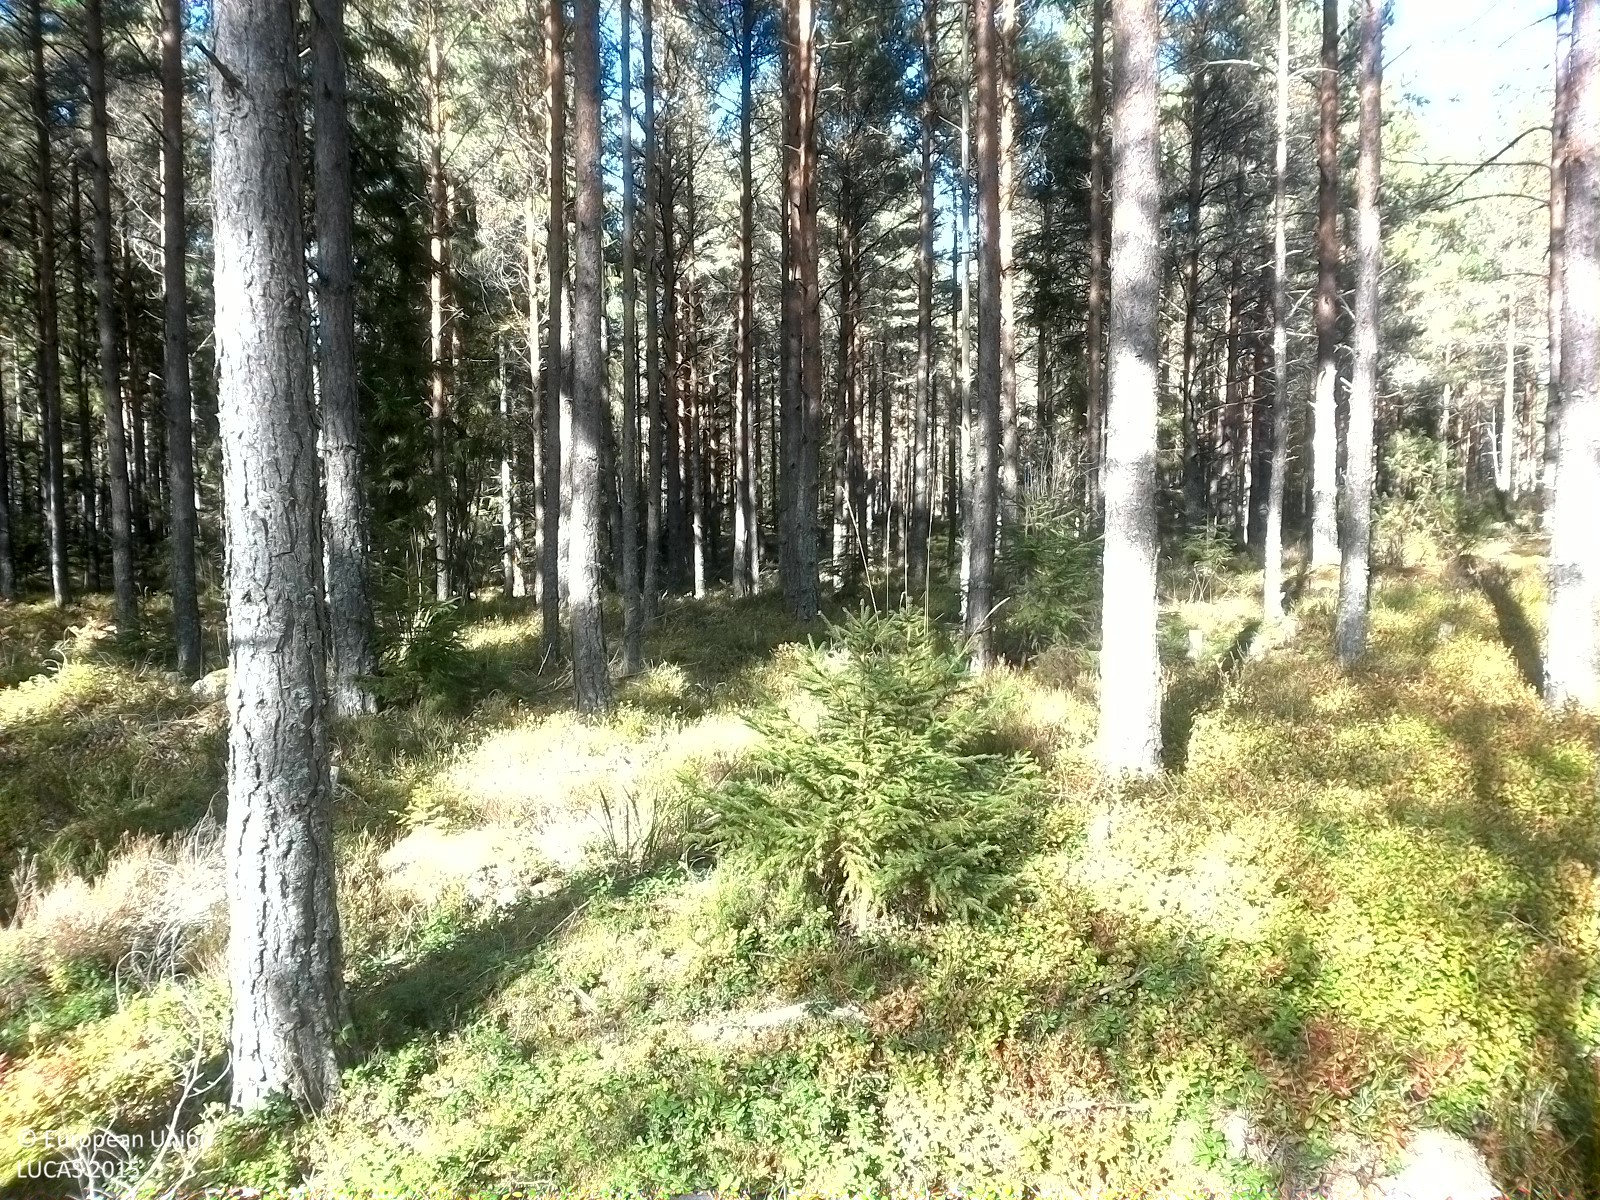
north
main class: Woodland
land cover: Pine dominated coniferous woodland
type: boreal forest
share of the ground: 25 - 50 %
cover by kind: herbaceous plants 40 %, coniferous forest trees 30 %, shrubs 15 %, lichens and mosses 10 %, broadleaved forest trees 5 %
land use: Forestry
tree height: > 5 m
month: September
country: SE
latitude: 58.6450
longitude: 16.7679
